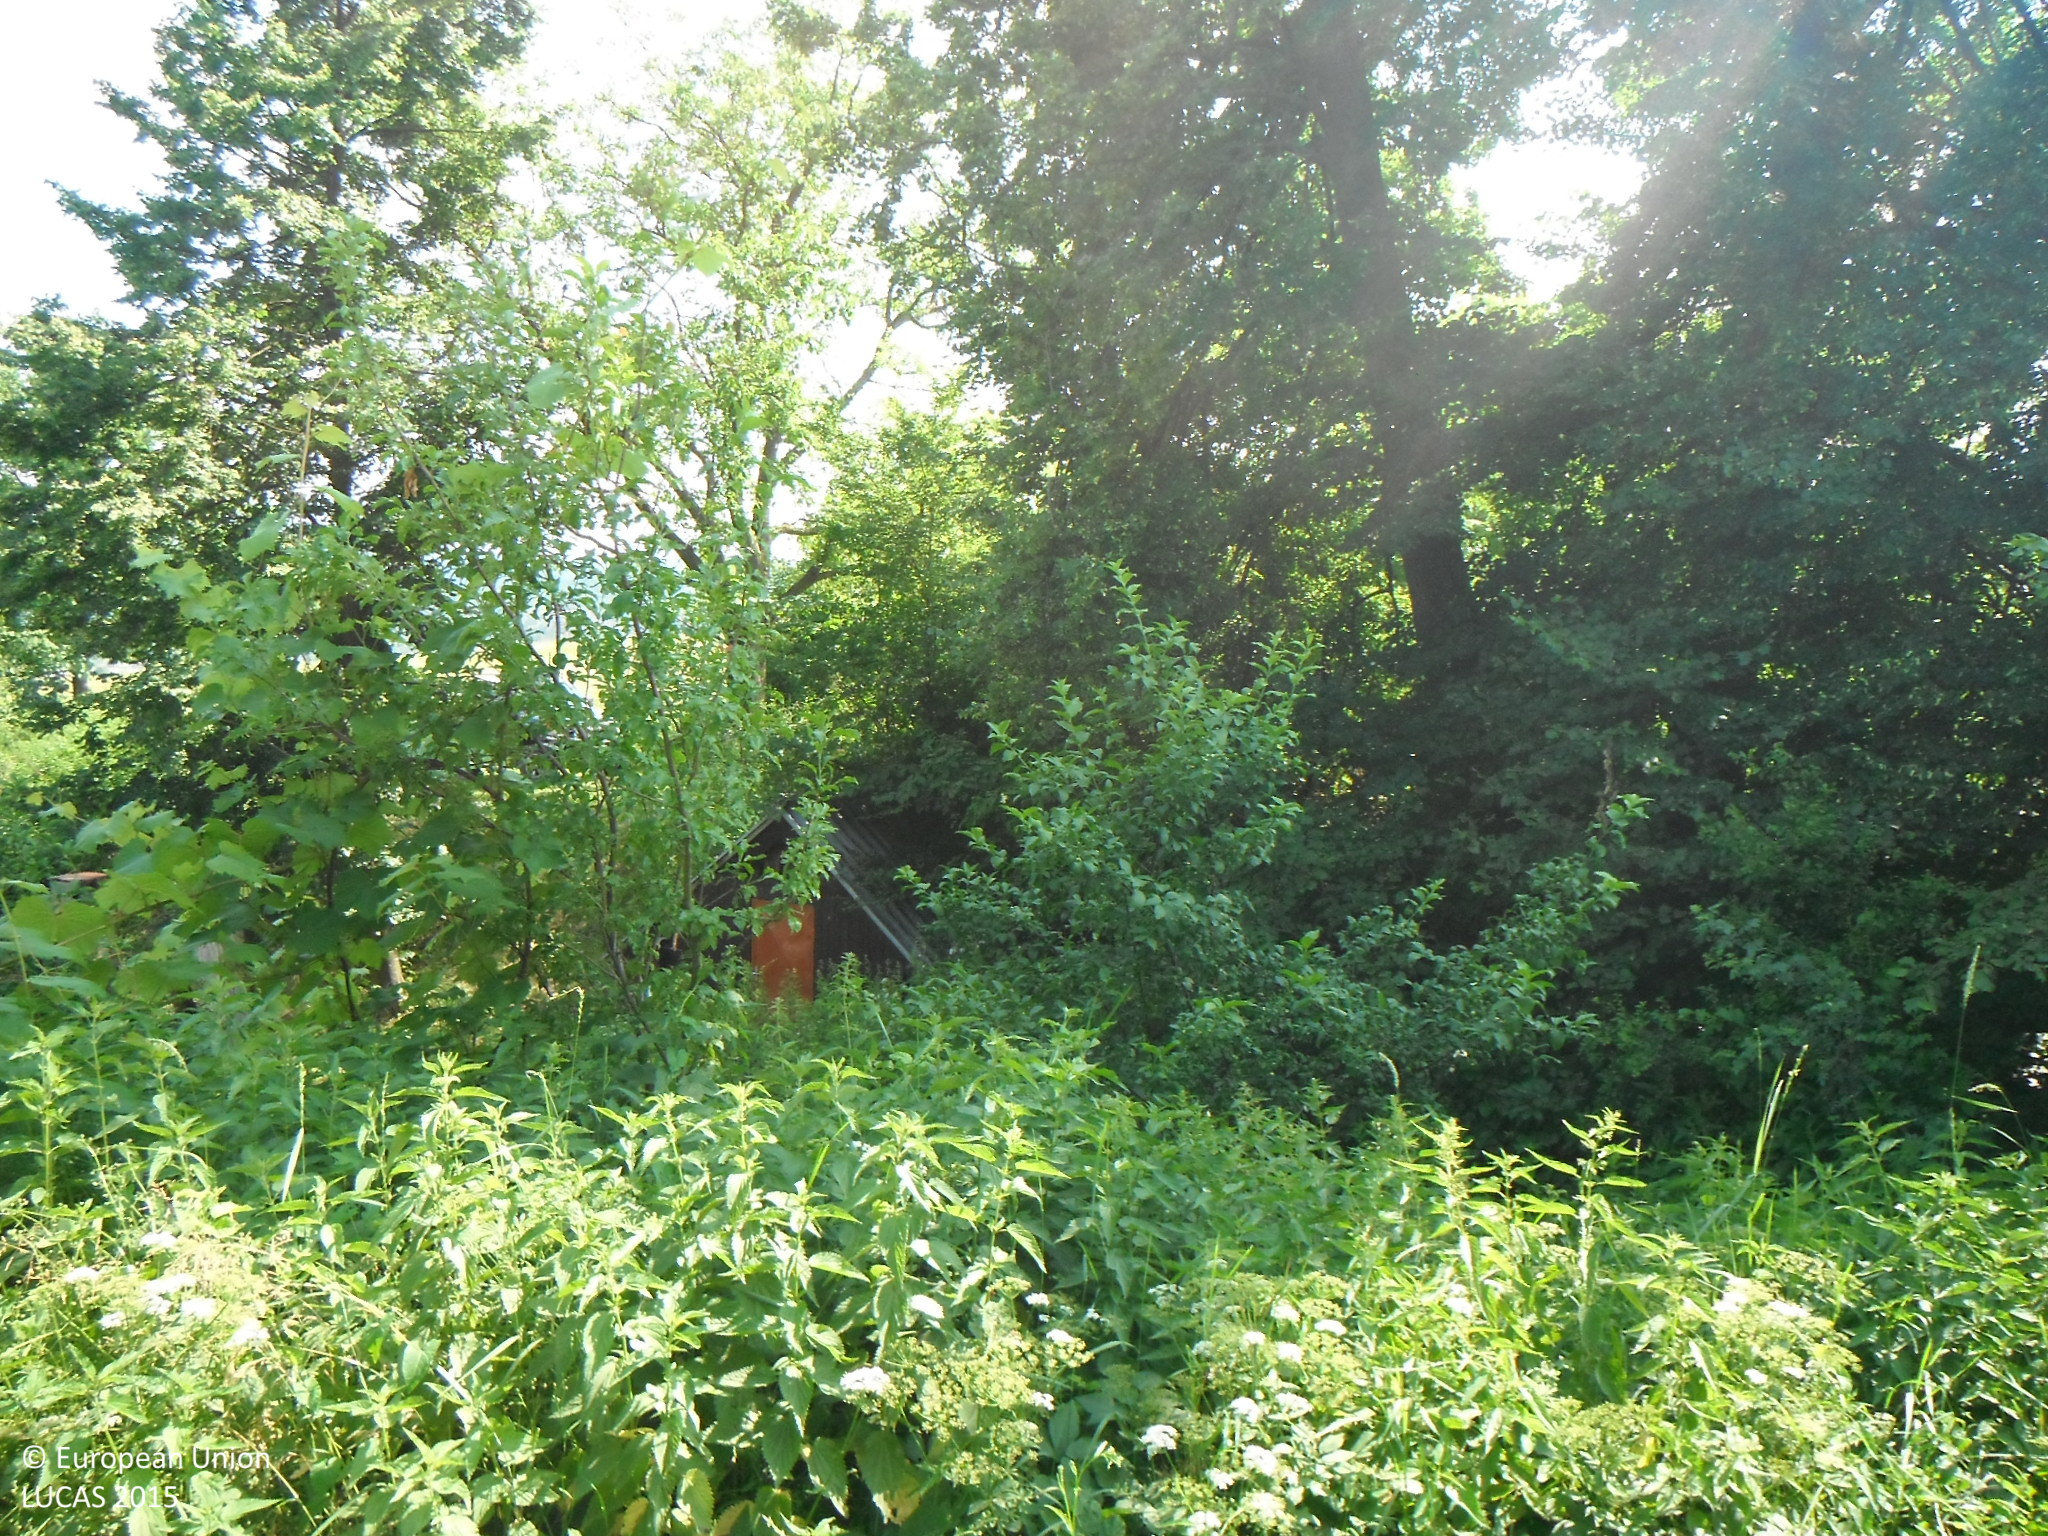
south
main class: Cropland
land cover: Apple fruit
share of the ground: 50 - 75 %
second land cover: Grassland without tree/shrub cover
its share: > 75 %
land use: Kitchen garden
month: June
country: SK
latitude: 48.4619
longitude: 19.5321
